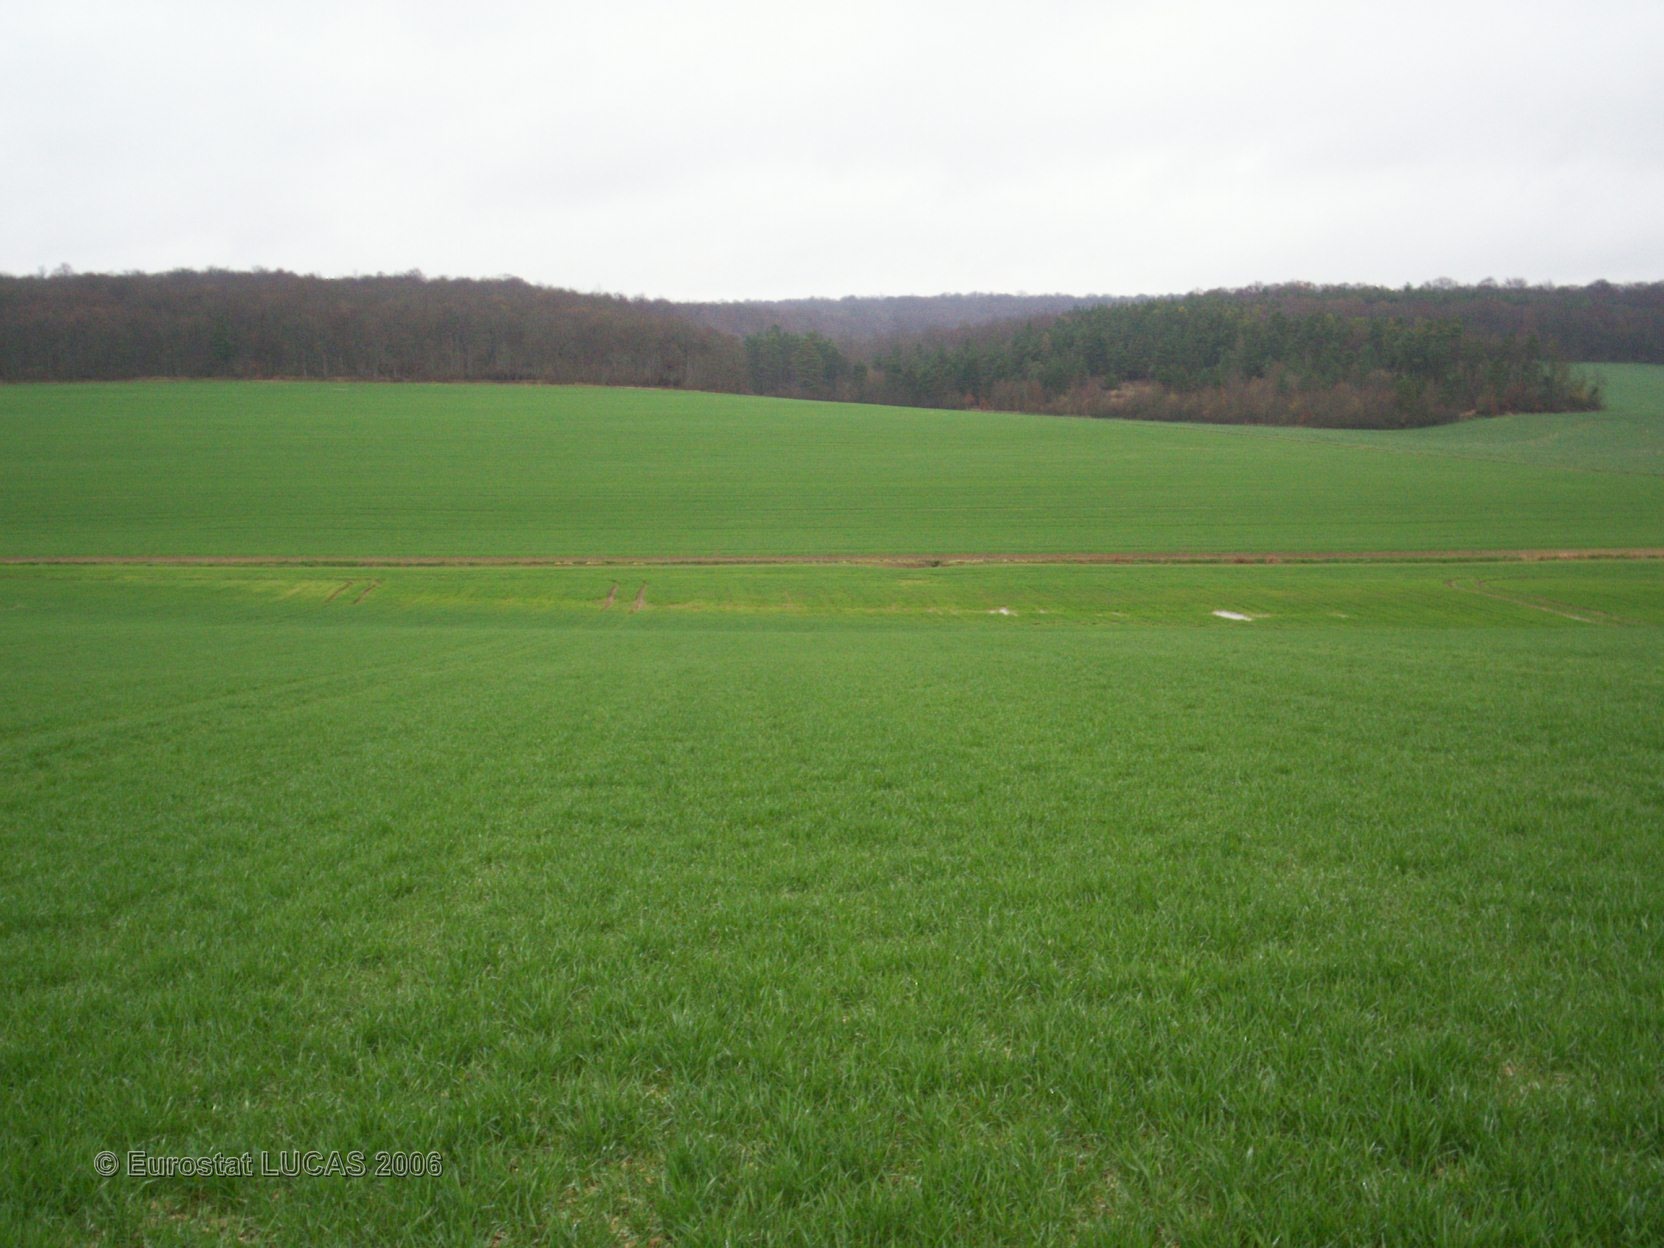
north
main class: Cropland
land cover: Common wheat
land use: Agriculture (excluding fallow land and kitchen gardens)
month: April
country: FR
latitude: 48.0035
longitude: 4.6504
